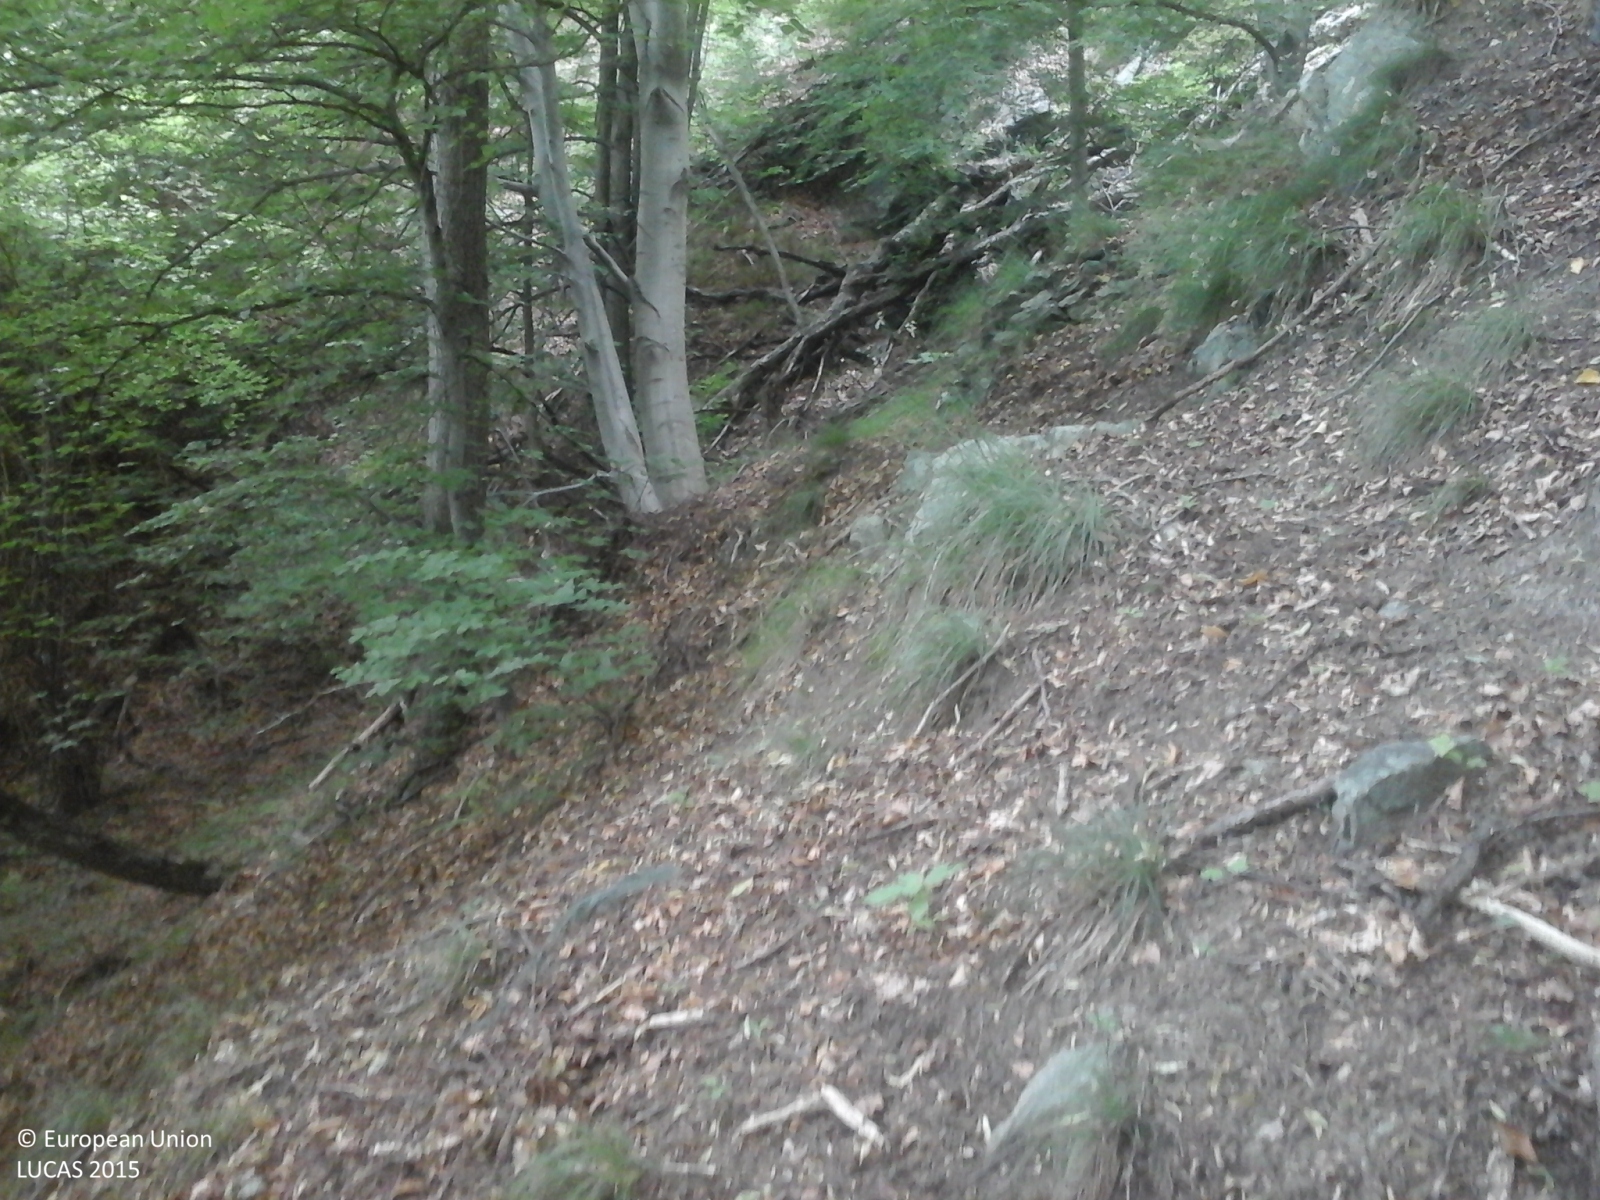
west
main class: Woodland
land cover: Broadleaved woodland
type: beech forest
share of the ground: > 75 %
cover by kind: broadleaved forest trees 100 %
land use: Forestry
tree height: > 5 m
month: July
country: IT
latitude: 45.1452
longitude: 7.2955
